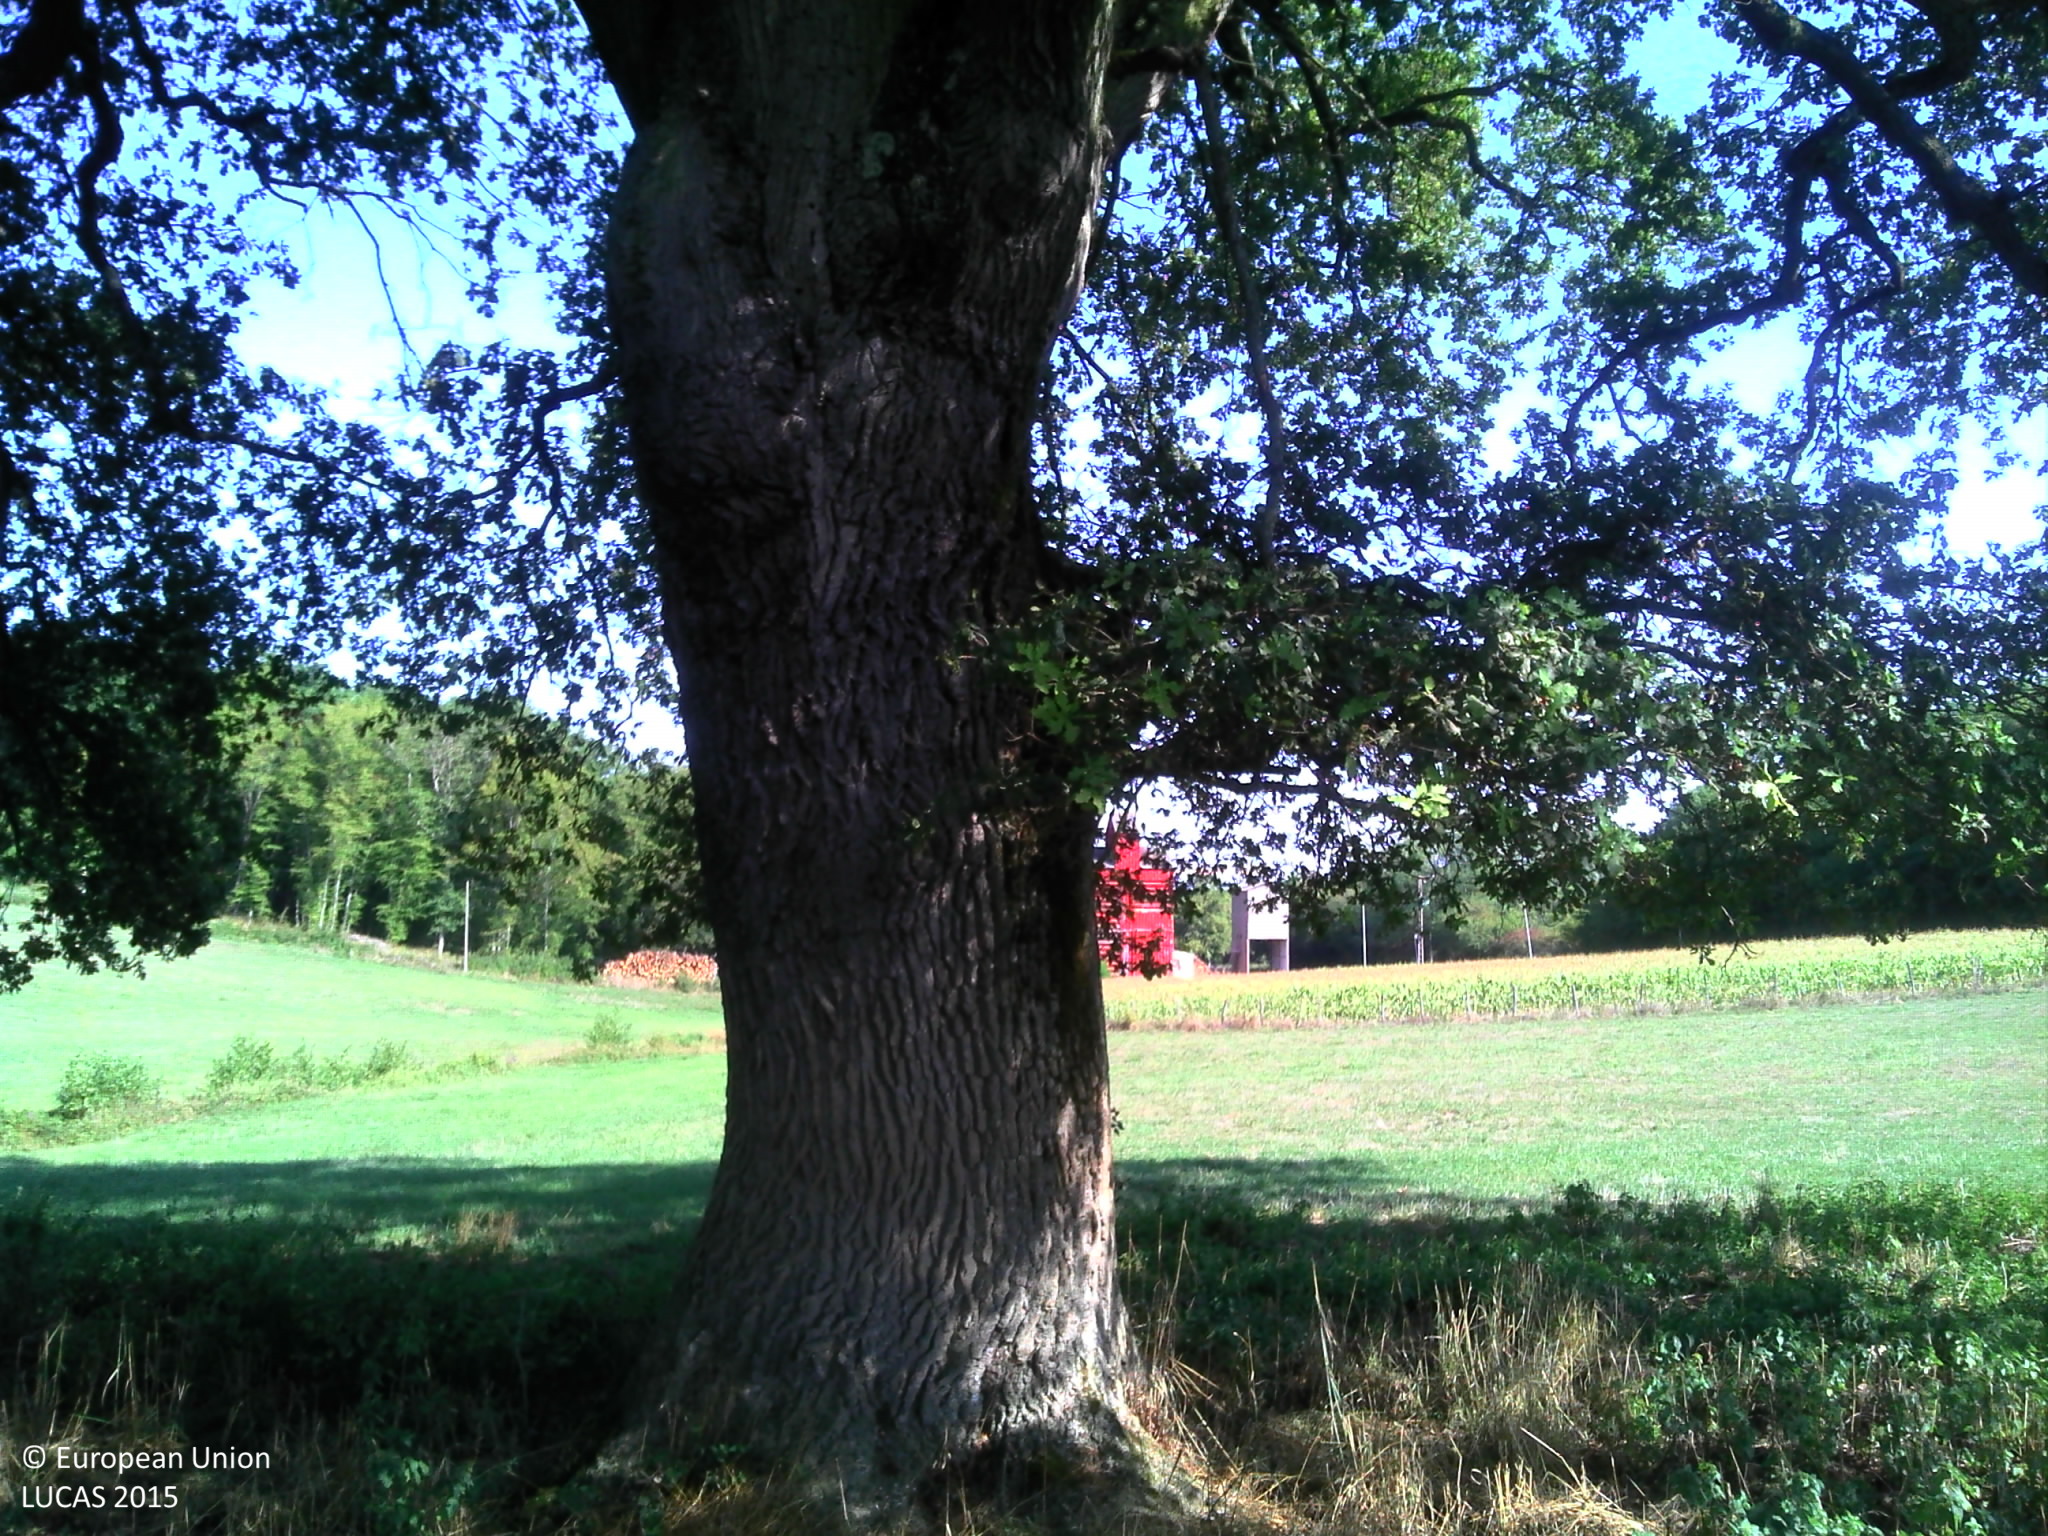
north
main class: Grassland
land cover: Grassland with sparse tree/shrub cover
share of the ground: > 75 %
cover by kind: herbaceous plants 95 %, broadleaved forest trees 5 %
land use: Agriculture (excluding fallow land and kitchen gardens)
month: August
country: FR
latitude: 46.3686
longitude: 4.7895
